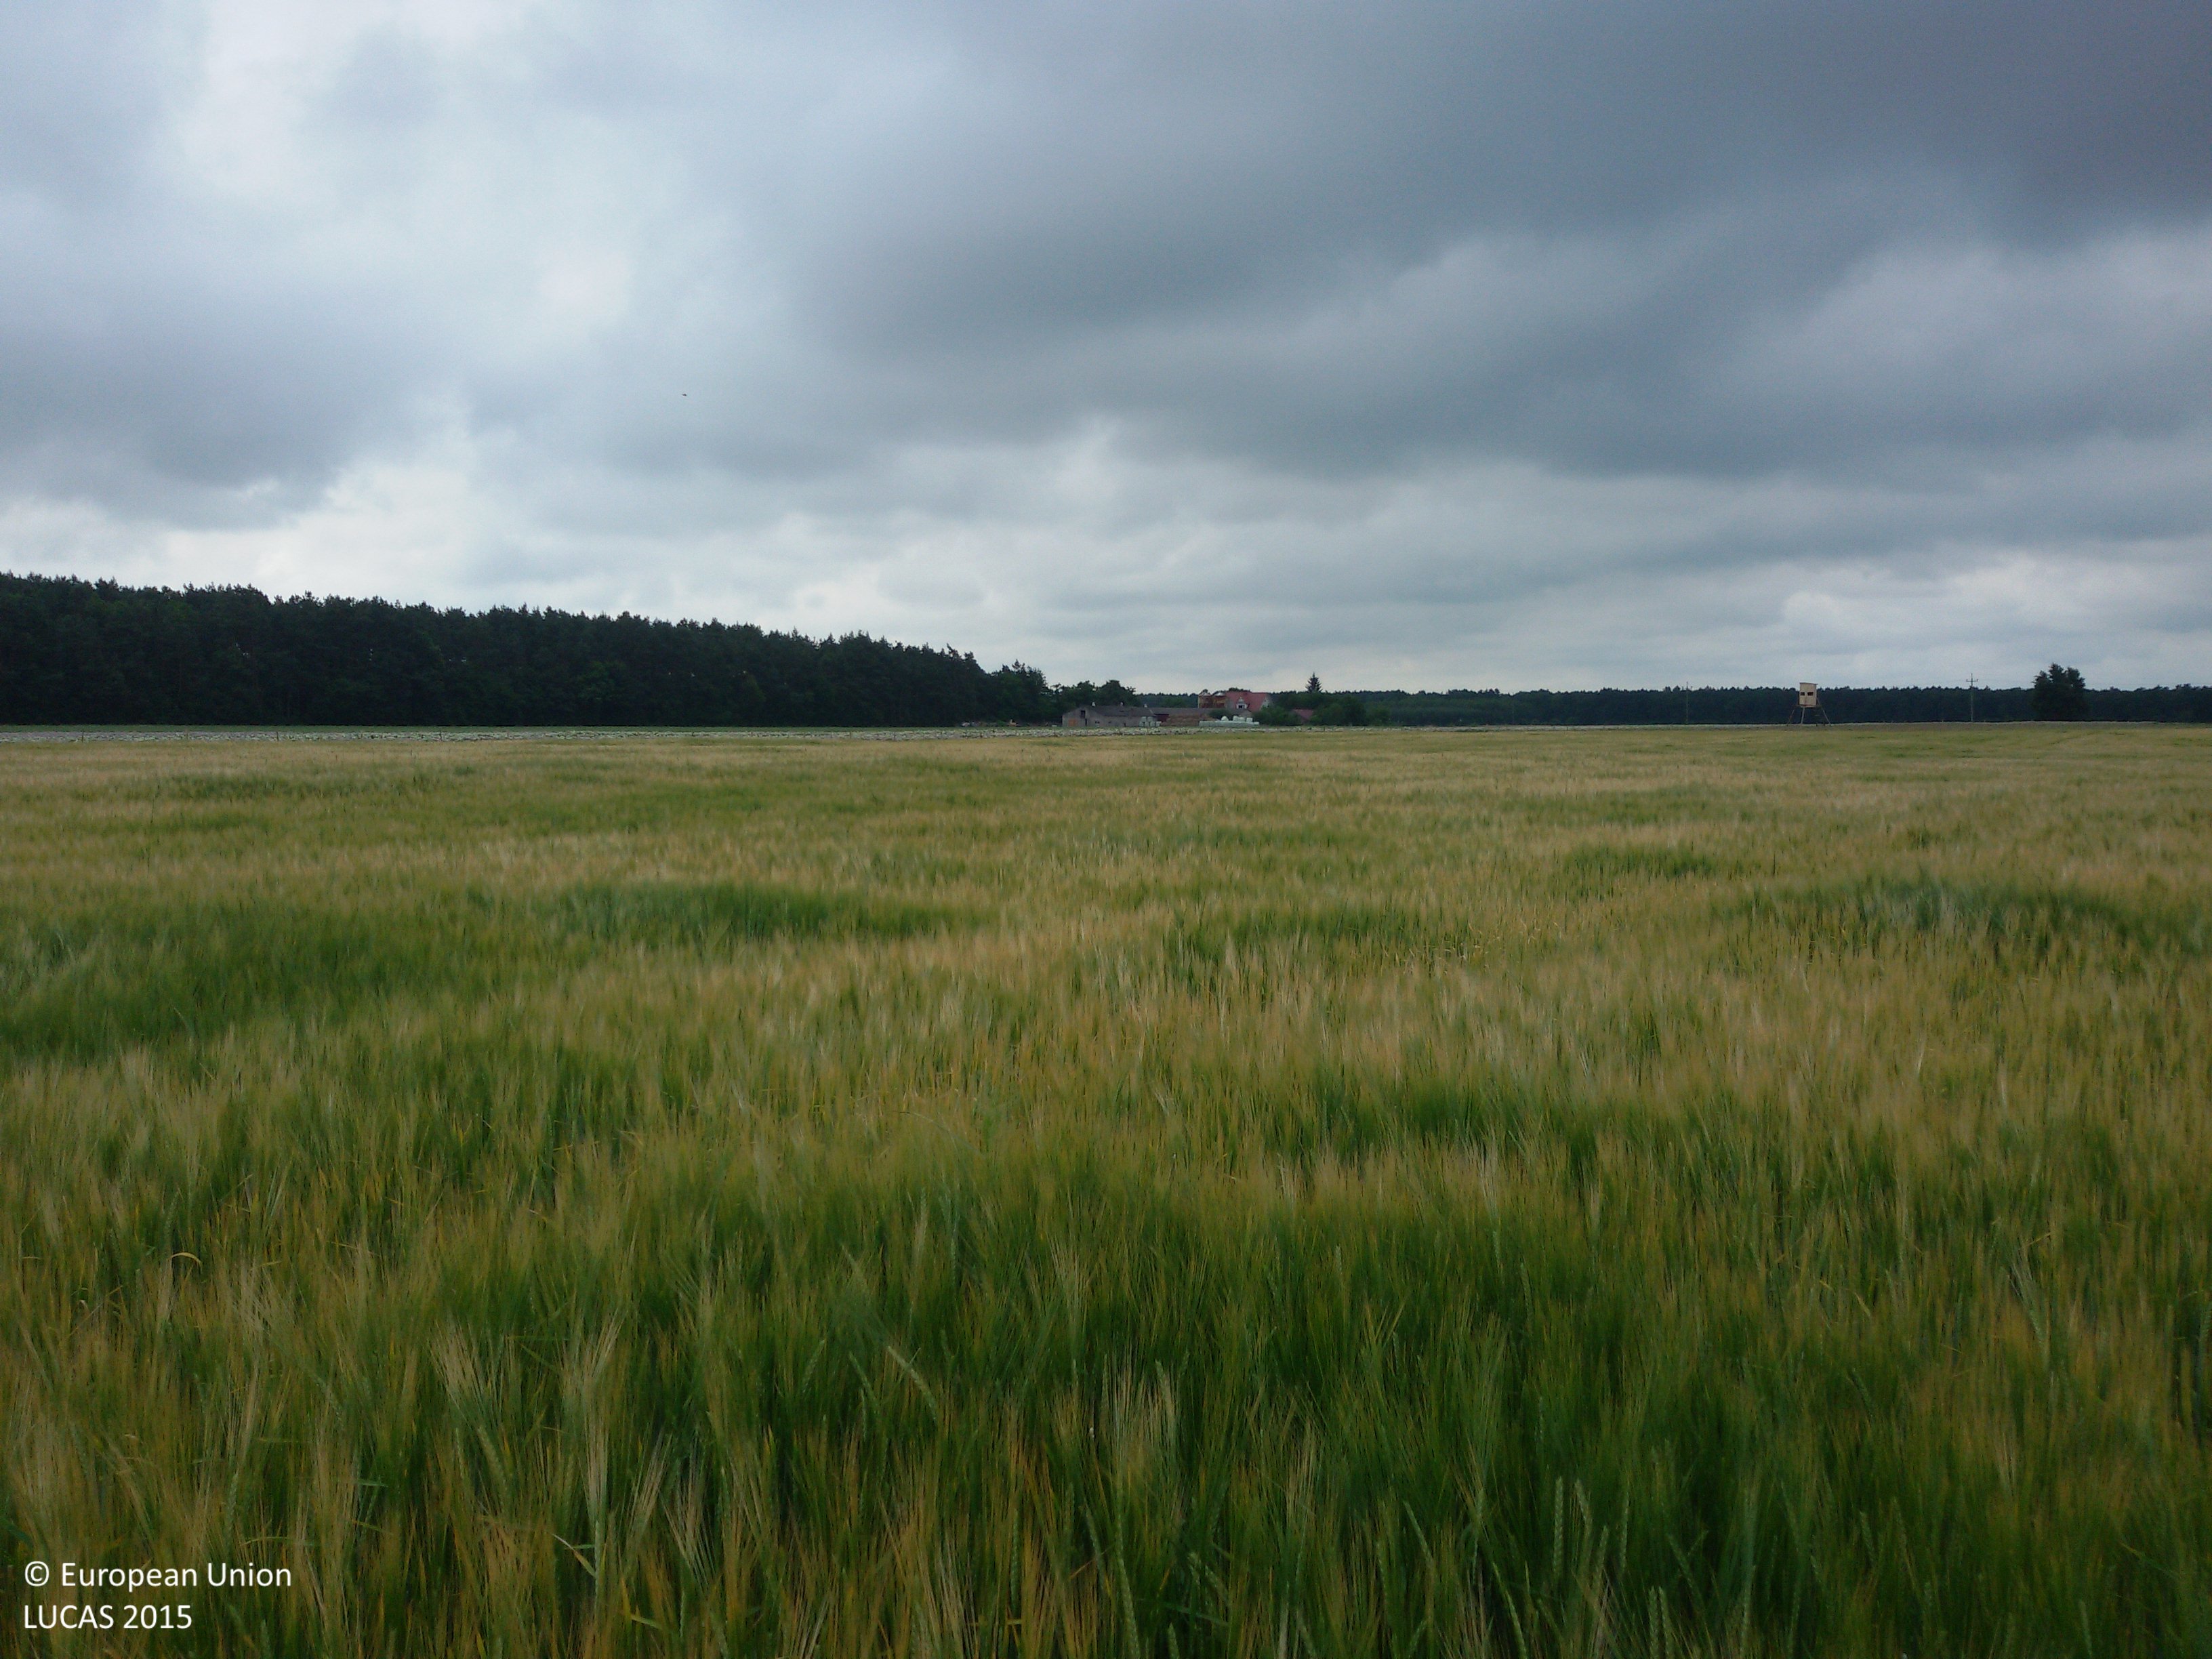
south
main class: Cropland
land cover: Barley
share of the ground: > 75 %
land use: Agriculture (excluding fallow land and kitchen gardens)
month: June
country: PL
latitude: 51.3749
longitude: 22.9315
